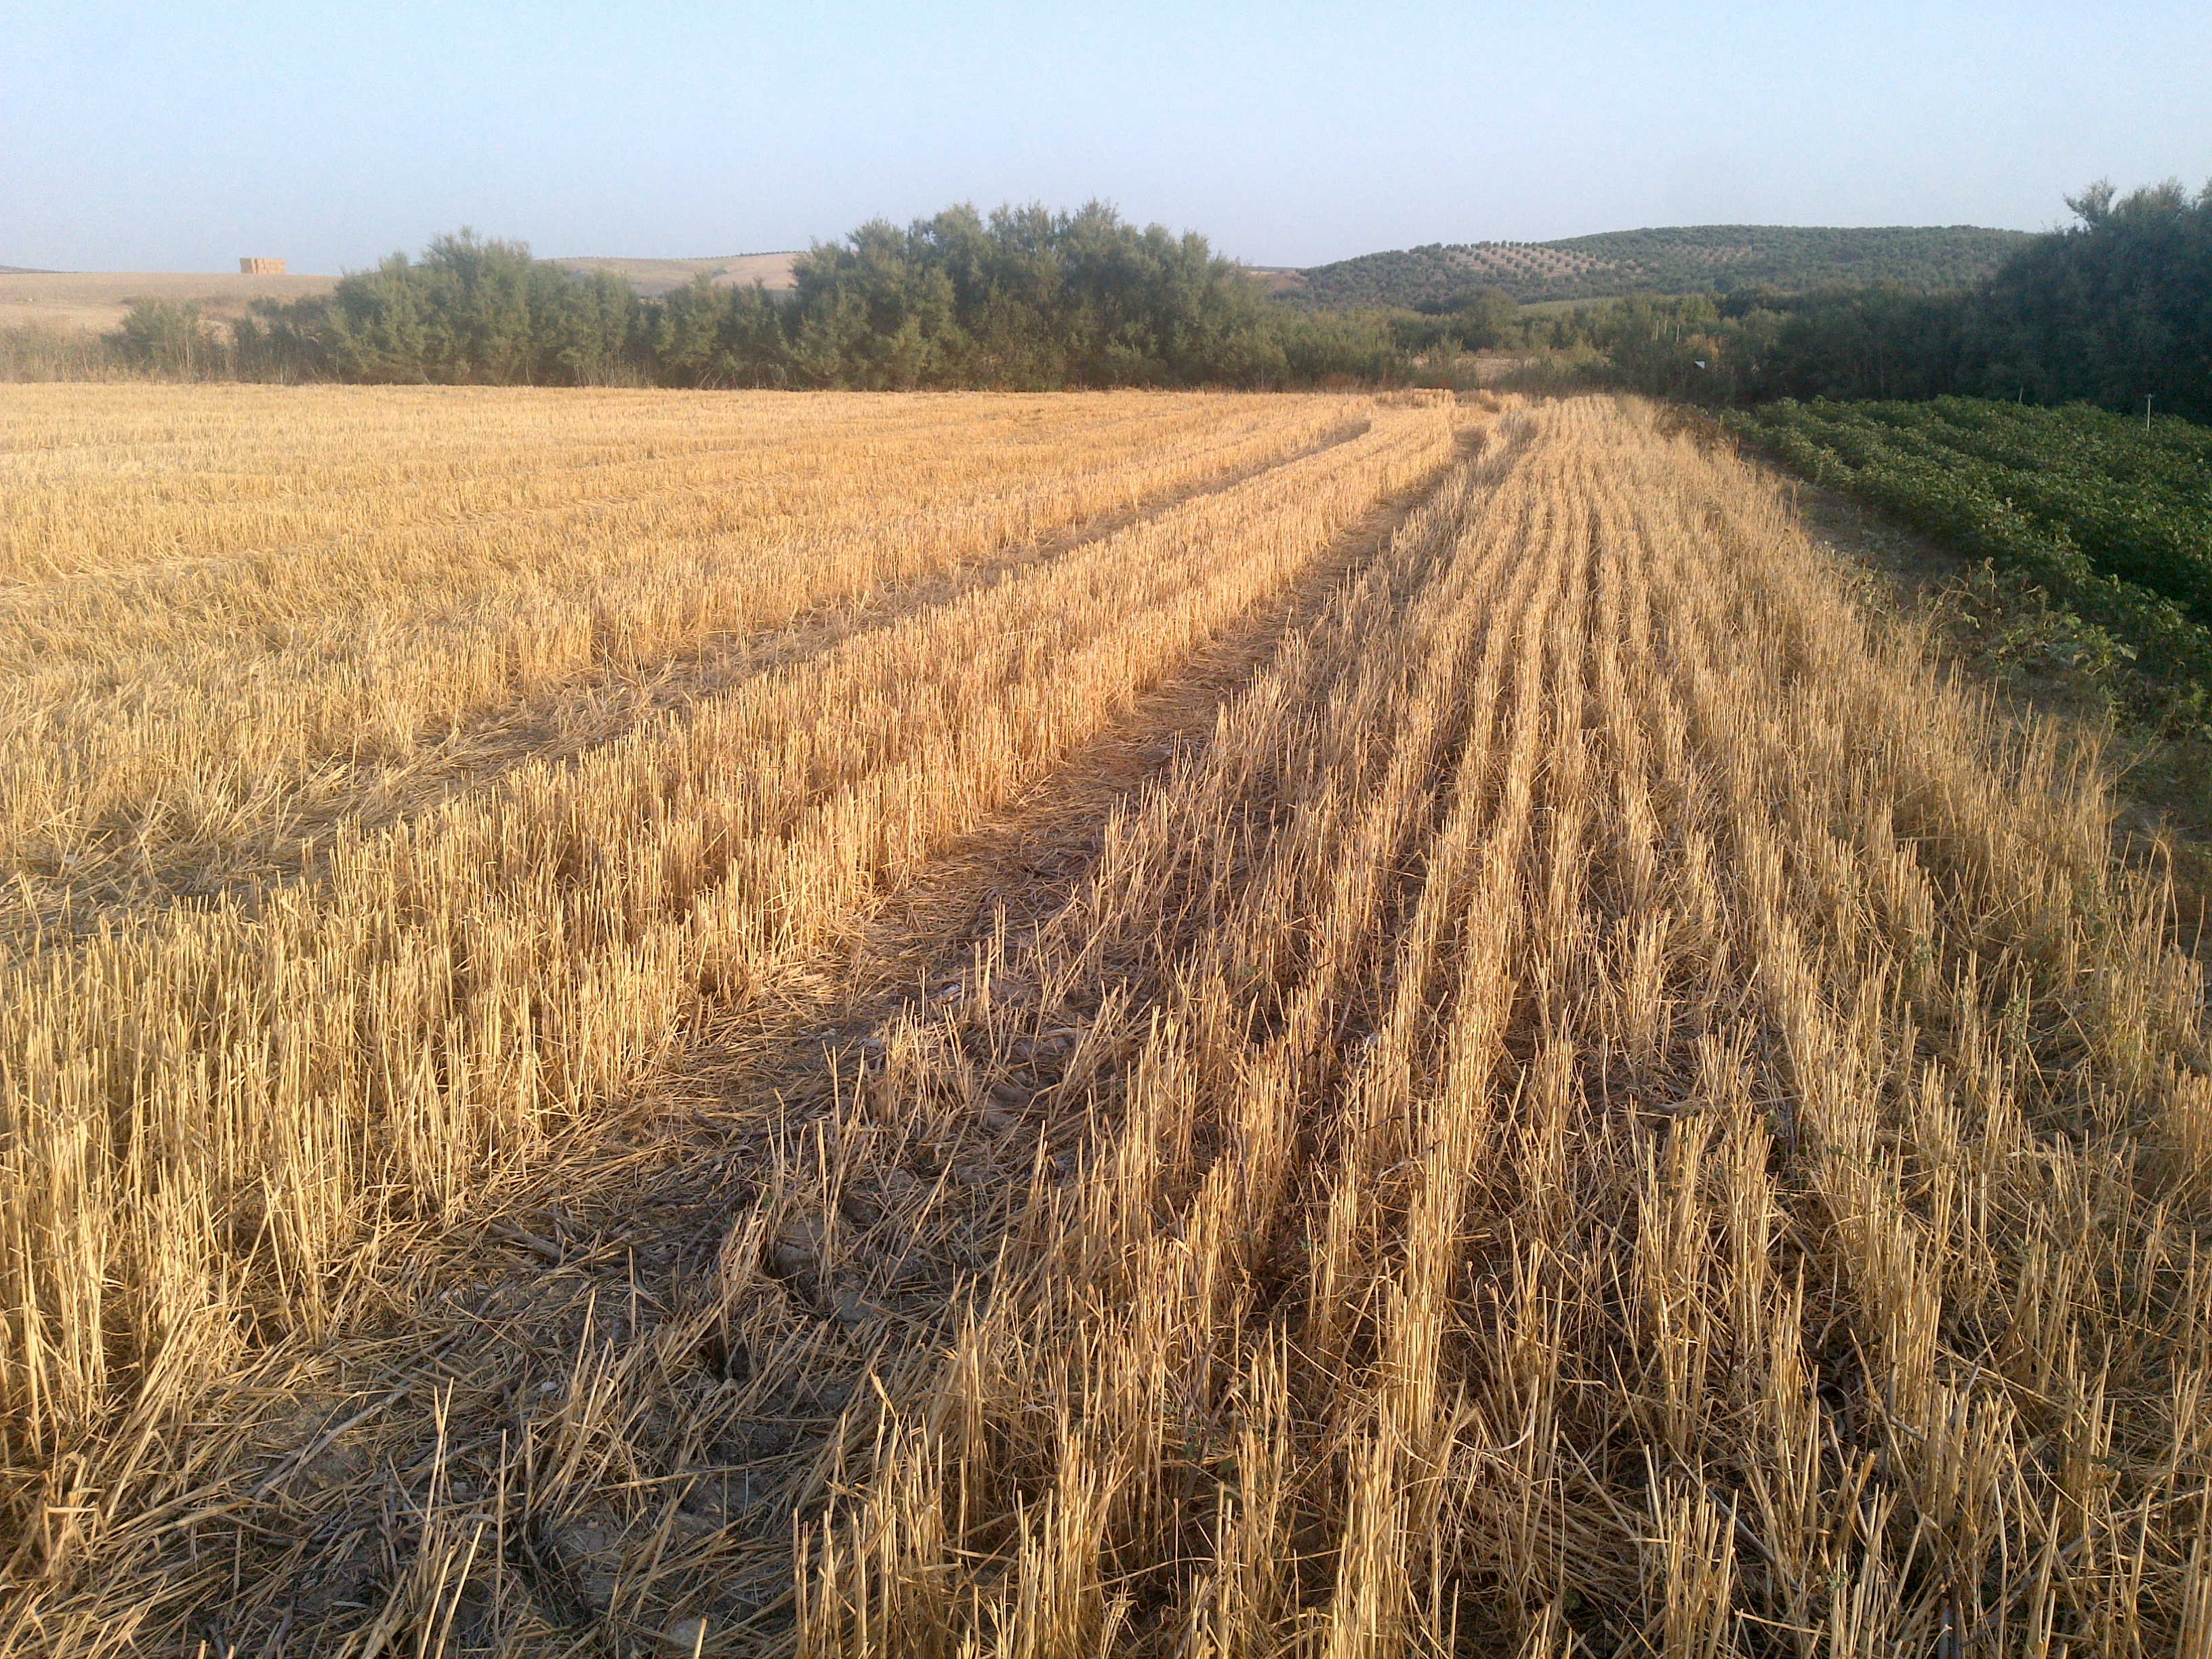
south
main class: Cropland
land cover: Durum wheat
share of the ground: < 10 %
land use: Agriculture (excluding fallow land and kitchen gardens)
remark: Harvested field
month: July
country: ES
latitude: 37.5108
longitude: -4.8633
